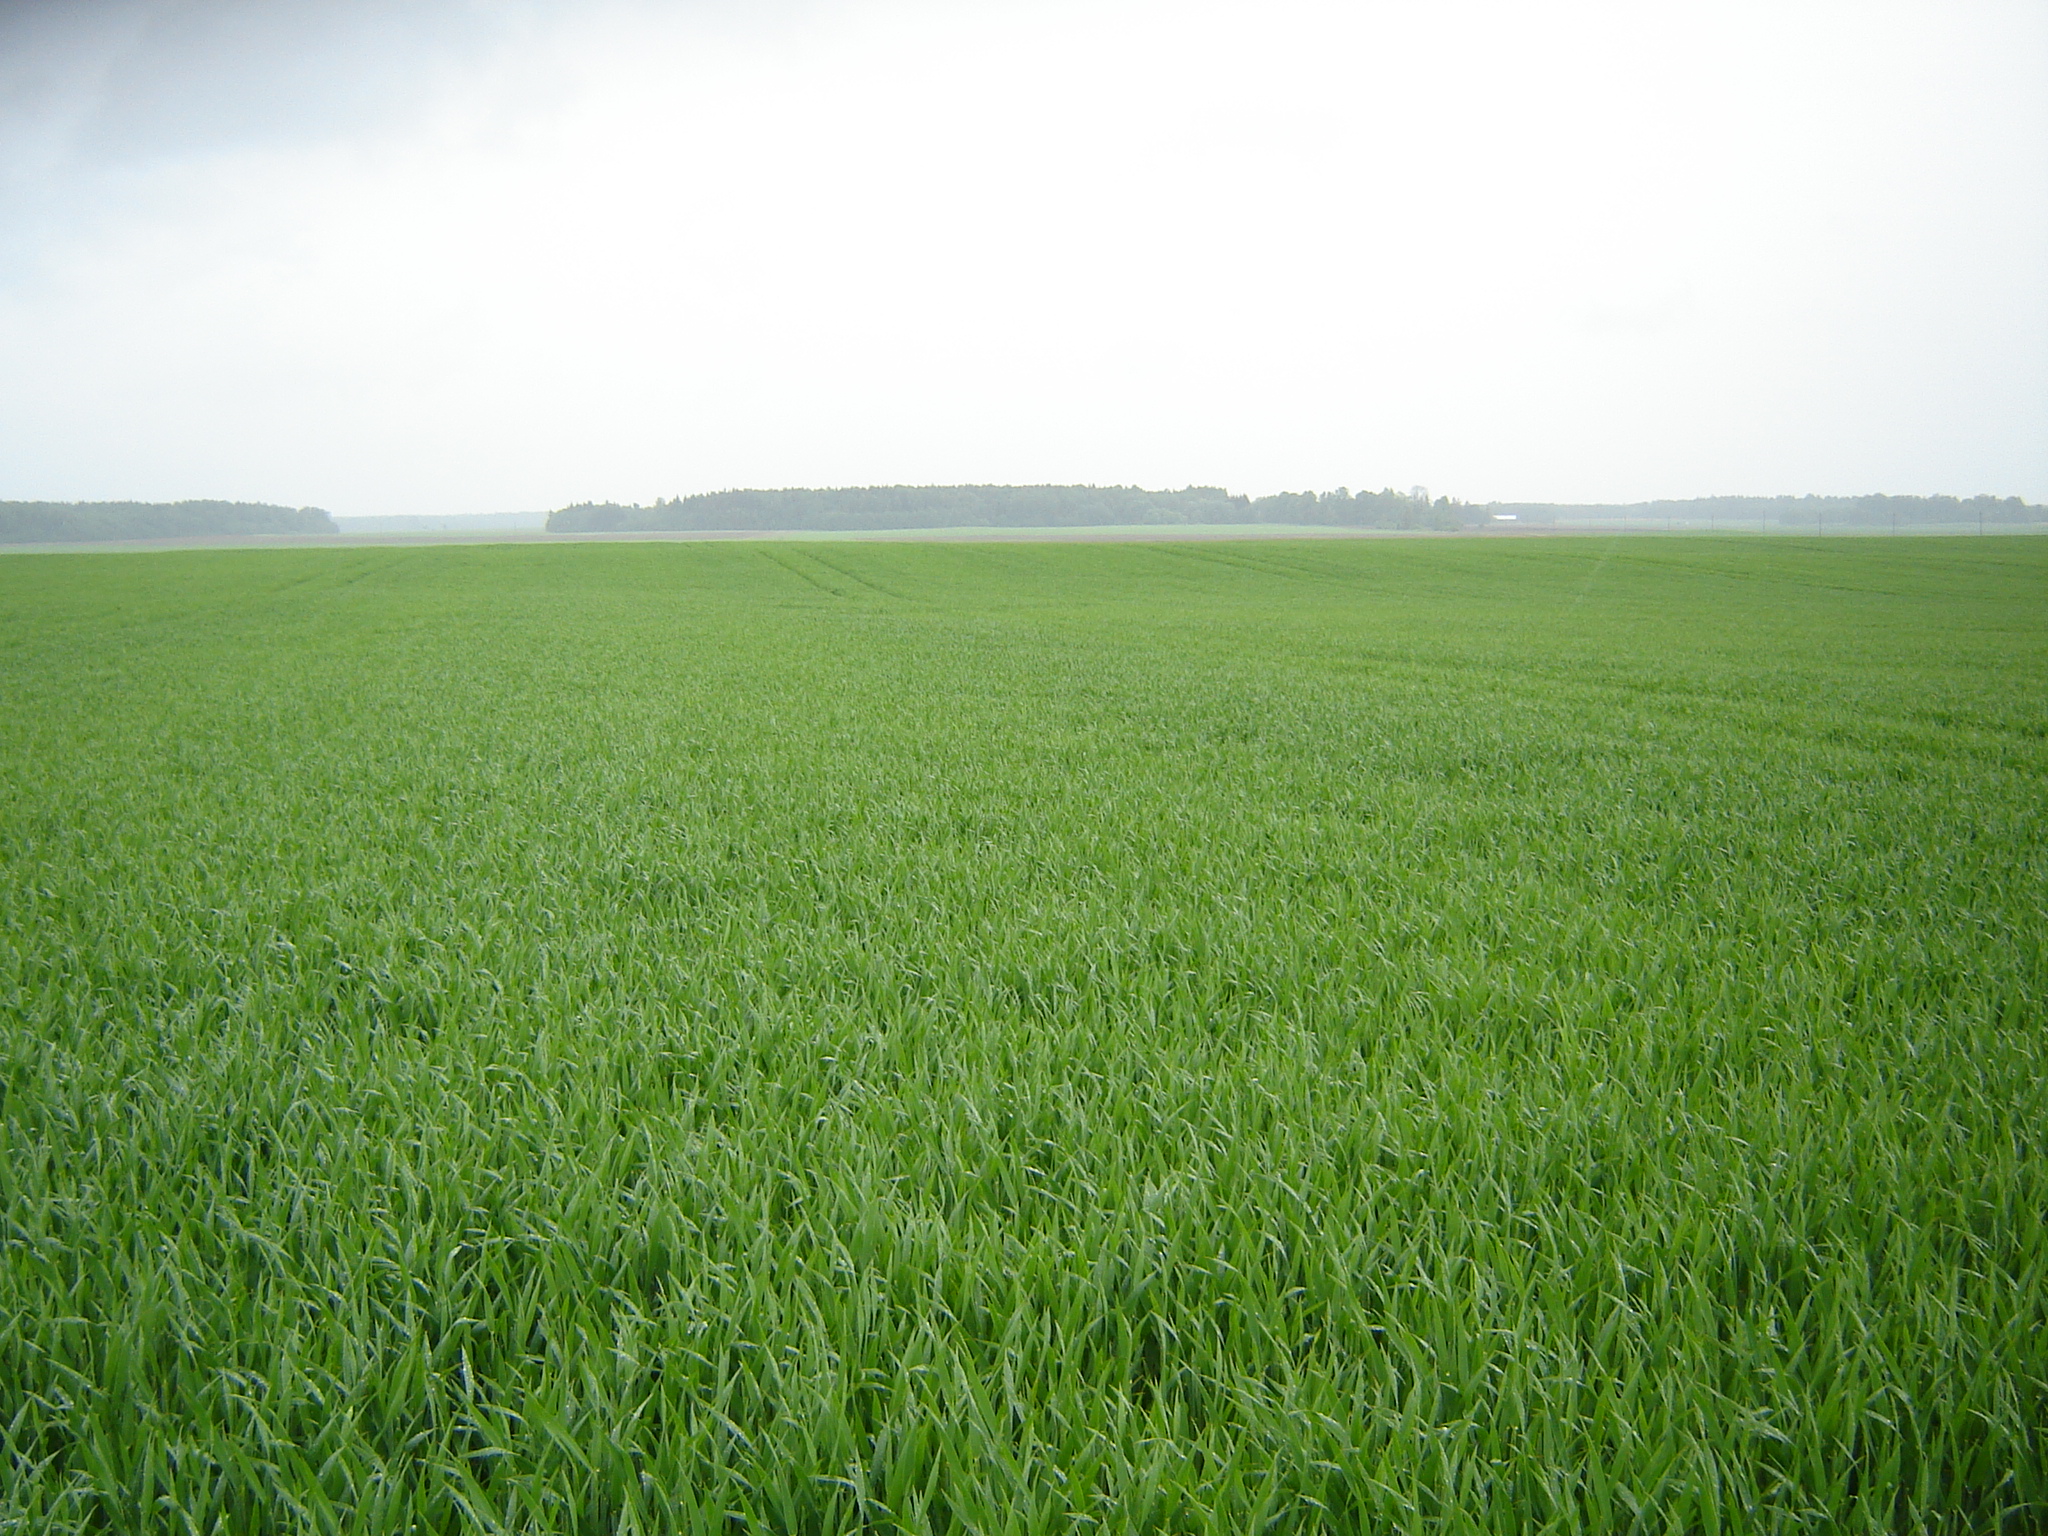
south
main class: Cropland
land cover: Barley
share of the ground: > 75 %
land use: Agriculture (excluding fallow land and kitchen gardens)
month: May
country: LT
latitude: 55.9821
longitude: 25.2622
